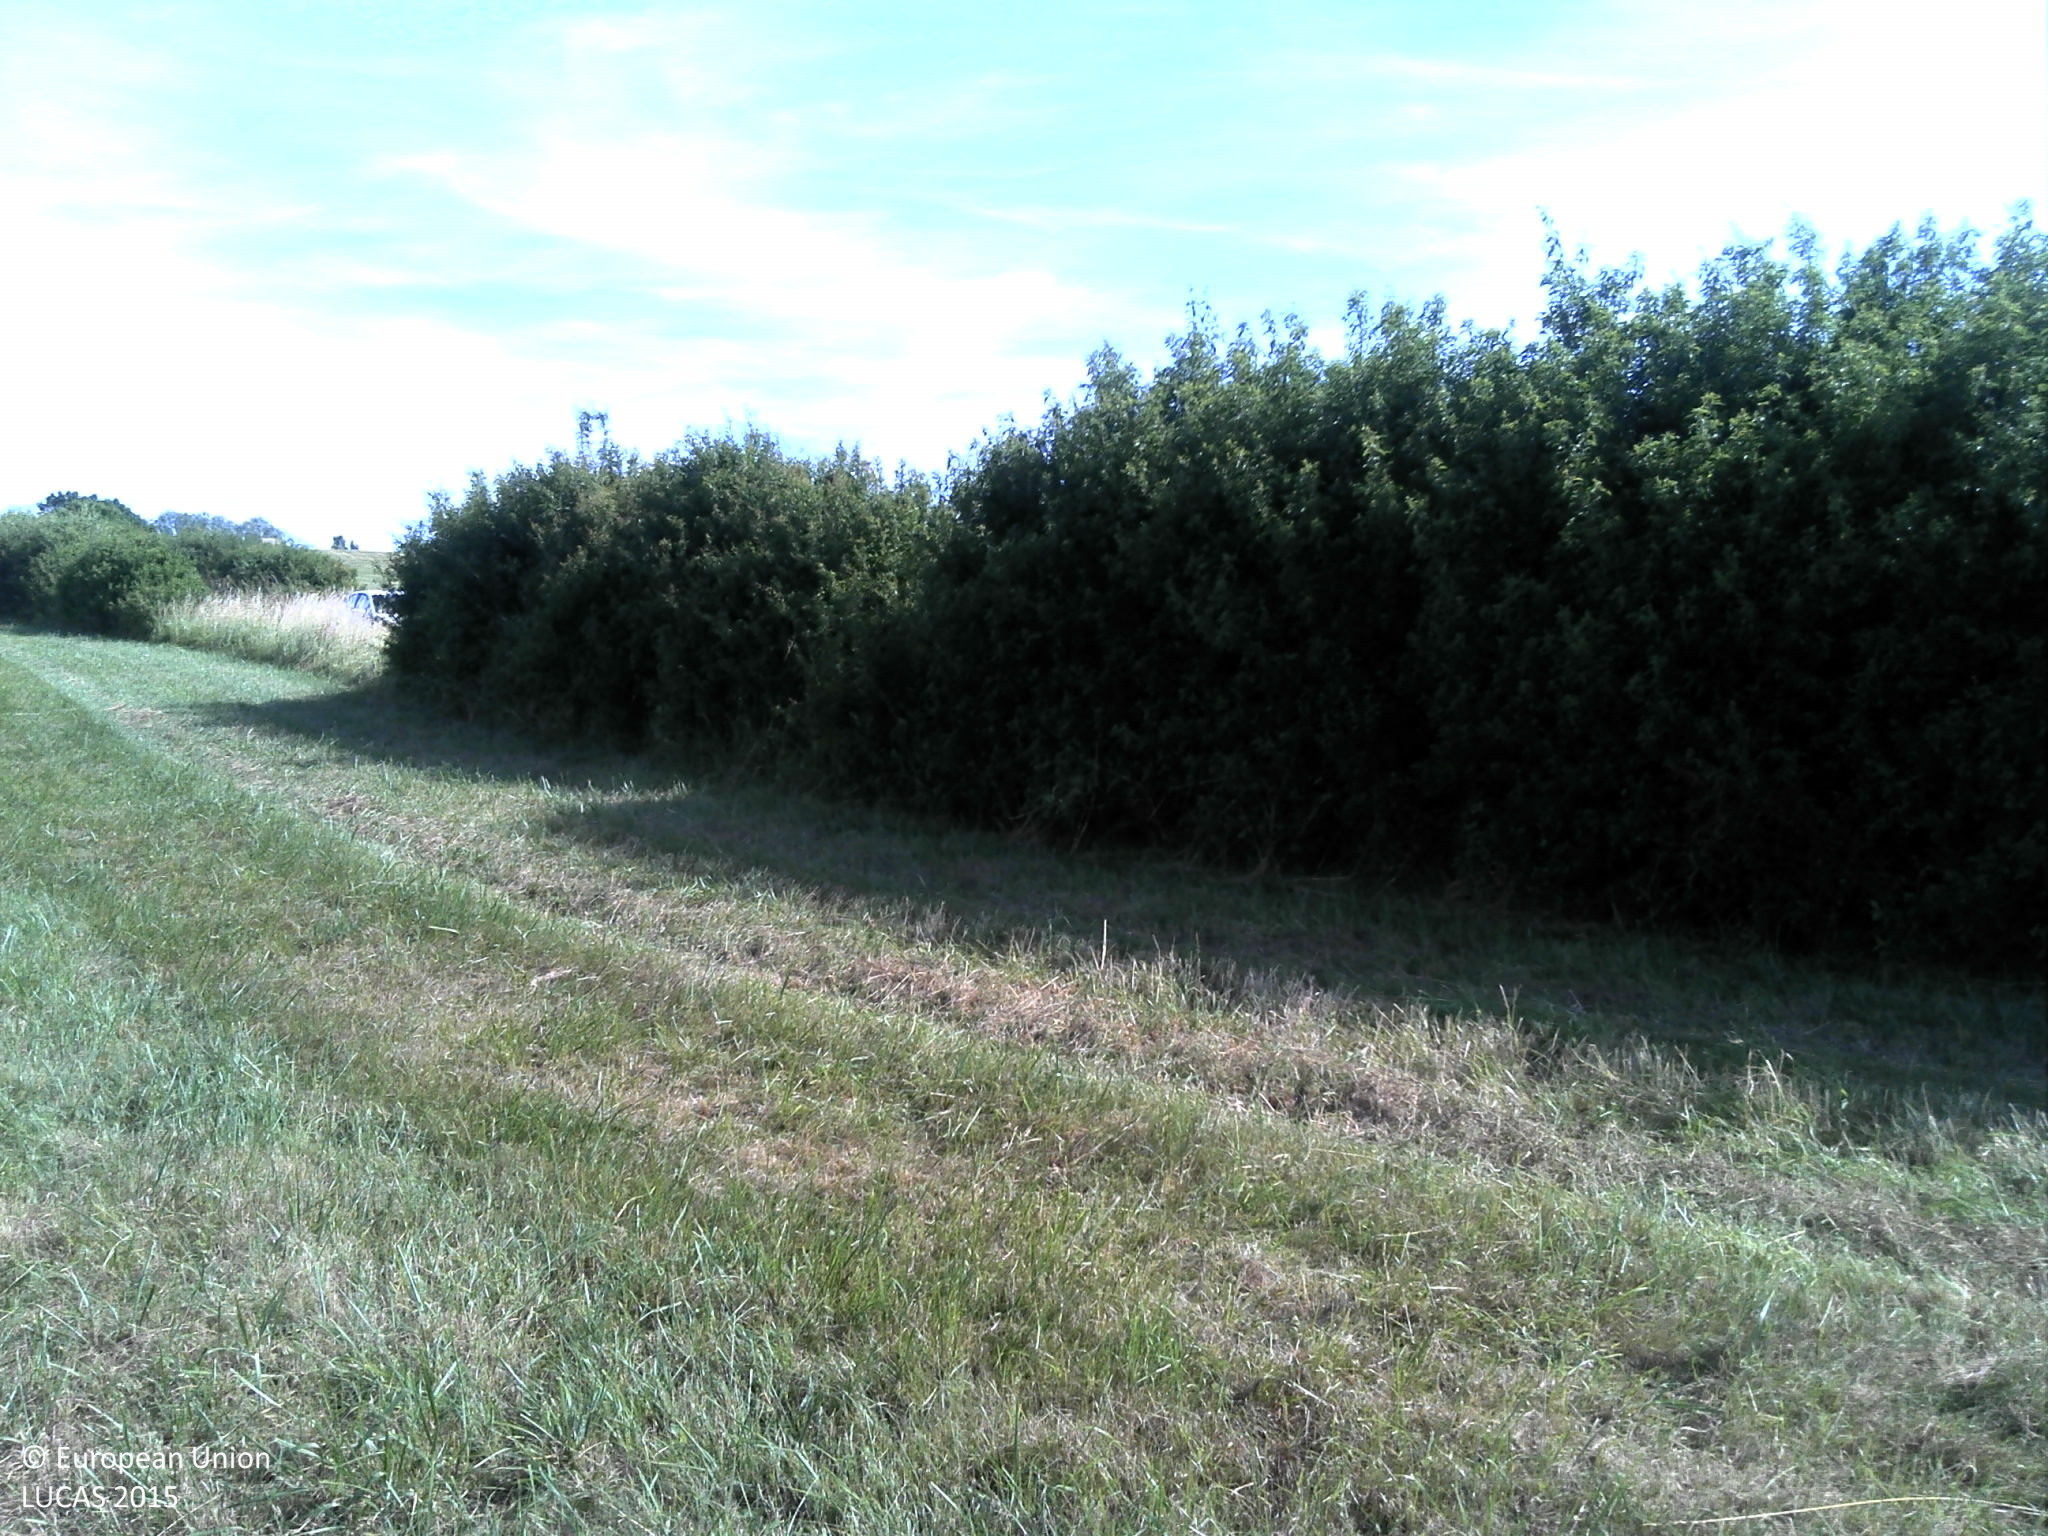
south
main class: Grassland
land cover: Grassland without tree/shrub cover
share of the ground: > 75 %
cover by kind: herbaceous plants 100 %
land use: Agriculture (excluding fallow land and kitchen gardens)
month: June
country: FR
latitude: 49.3387
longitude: 5.9669
